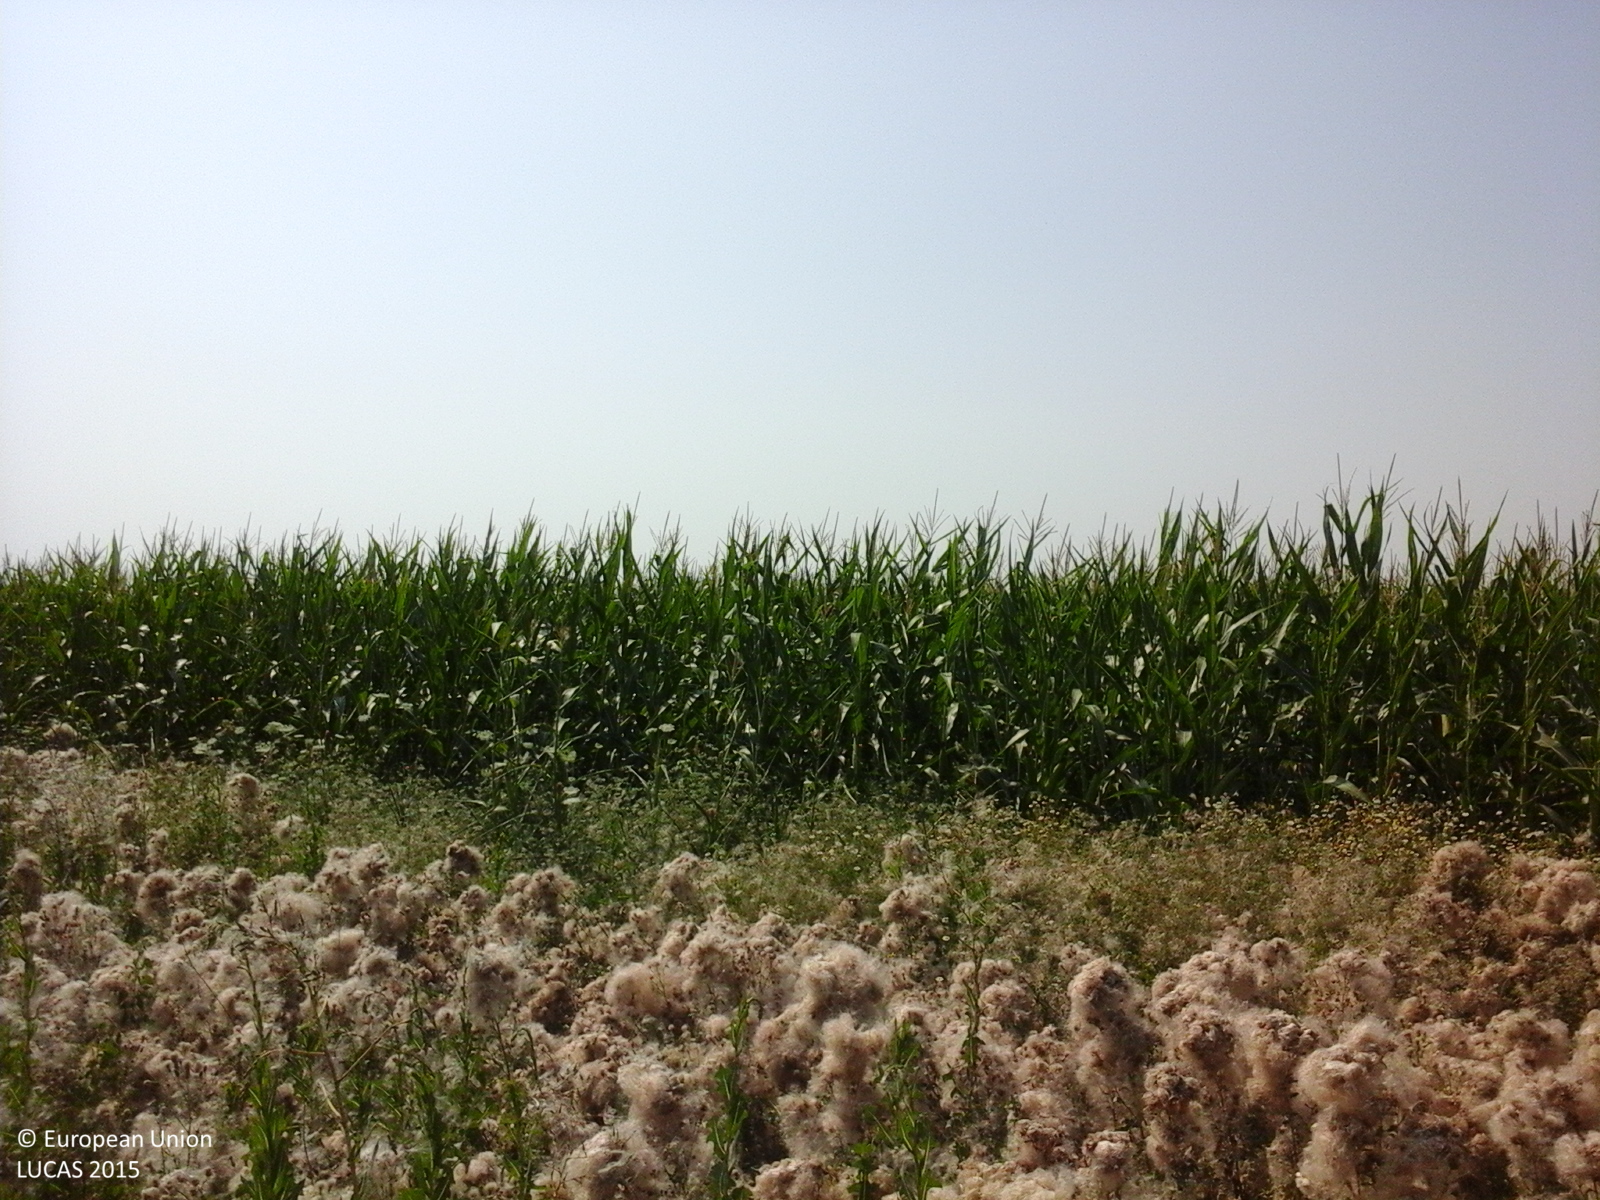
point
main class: Cropland
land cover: Maize
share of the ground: > 75 %
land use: Agriculture (excluding fallow land and kitchen gardens)
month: July
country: RO
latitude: 44.8168
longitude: 26.8586
